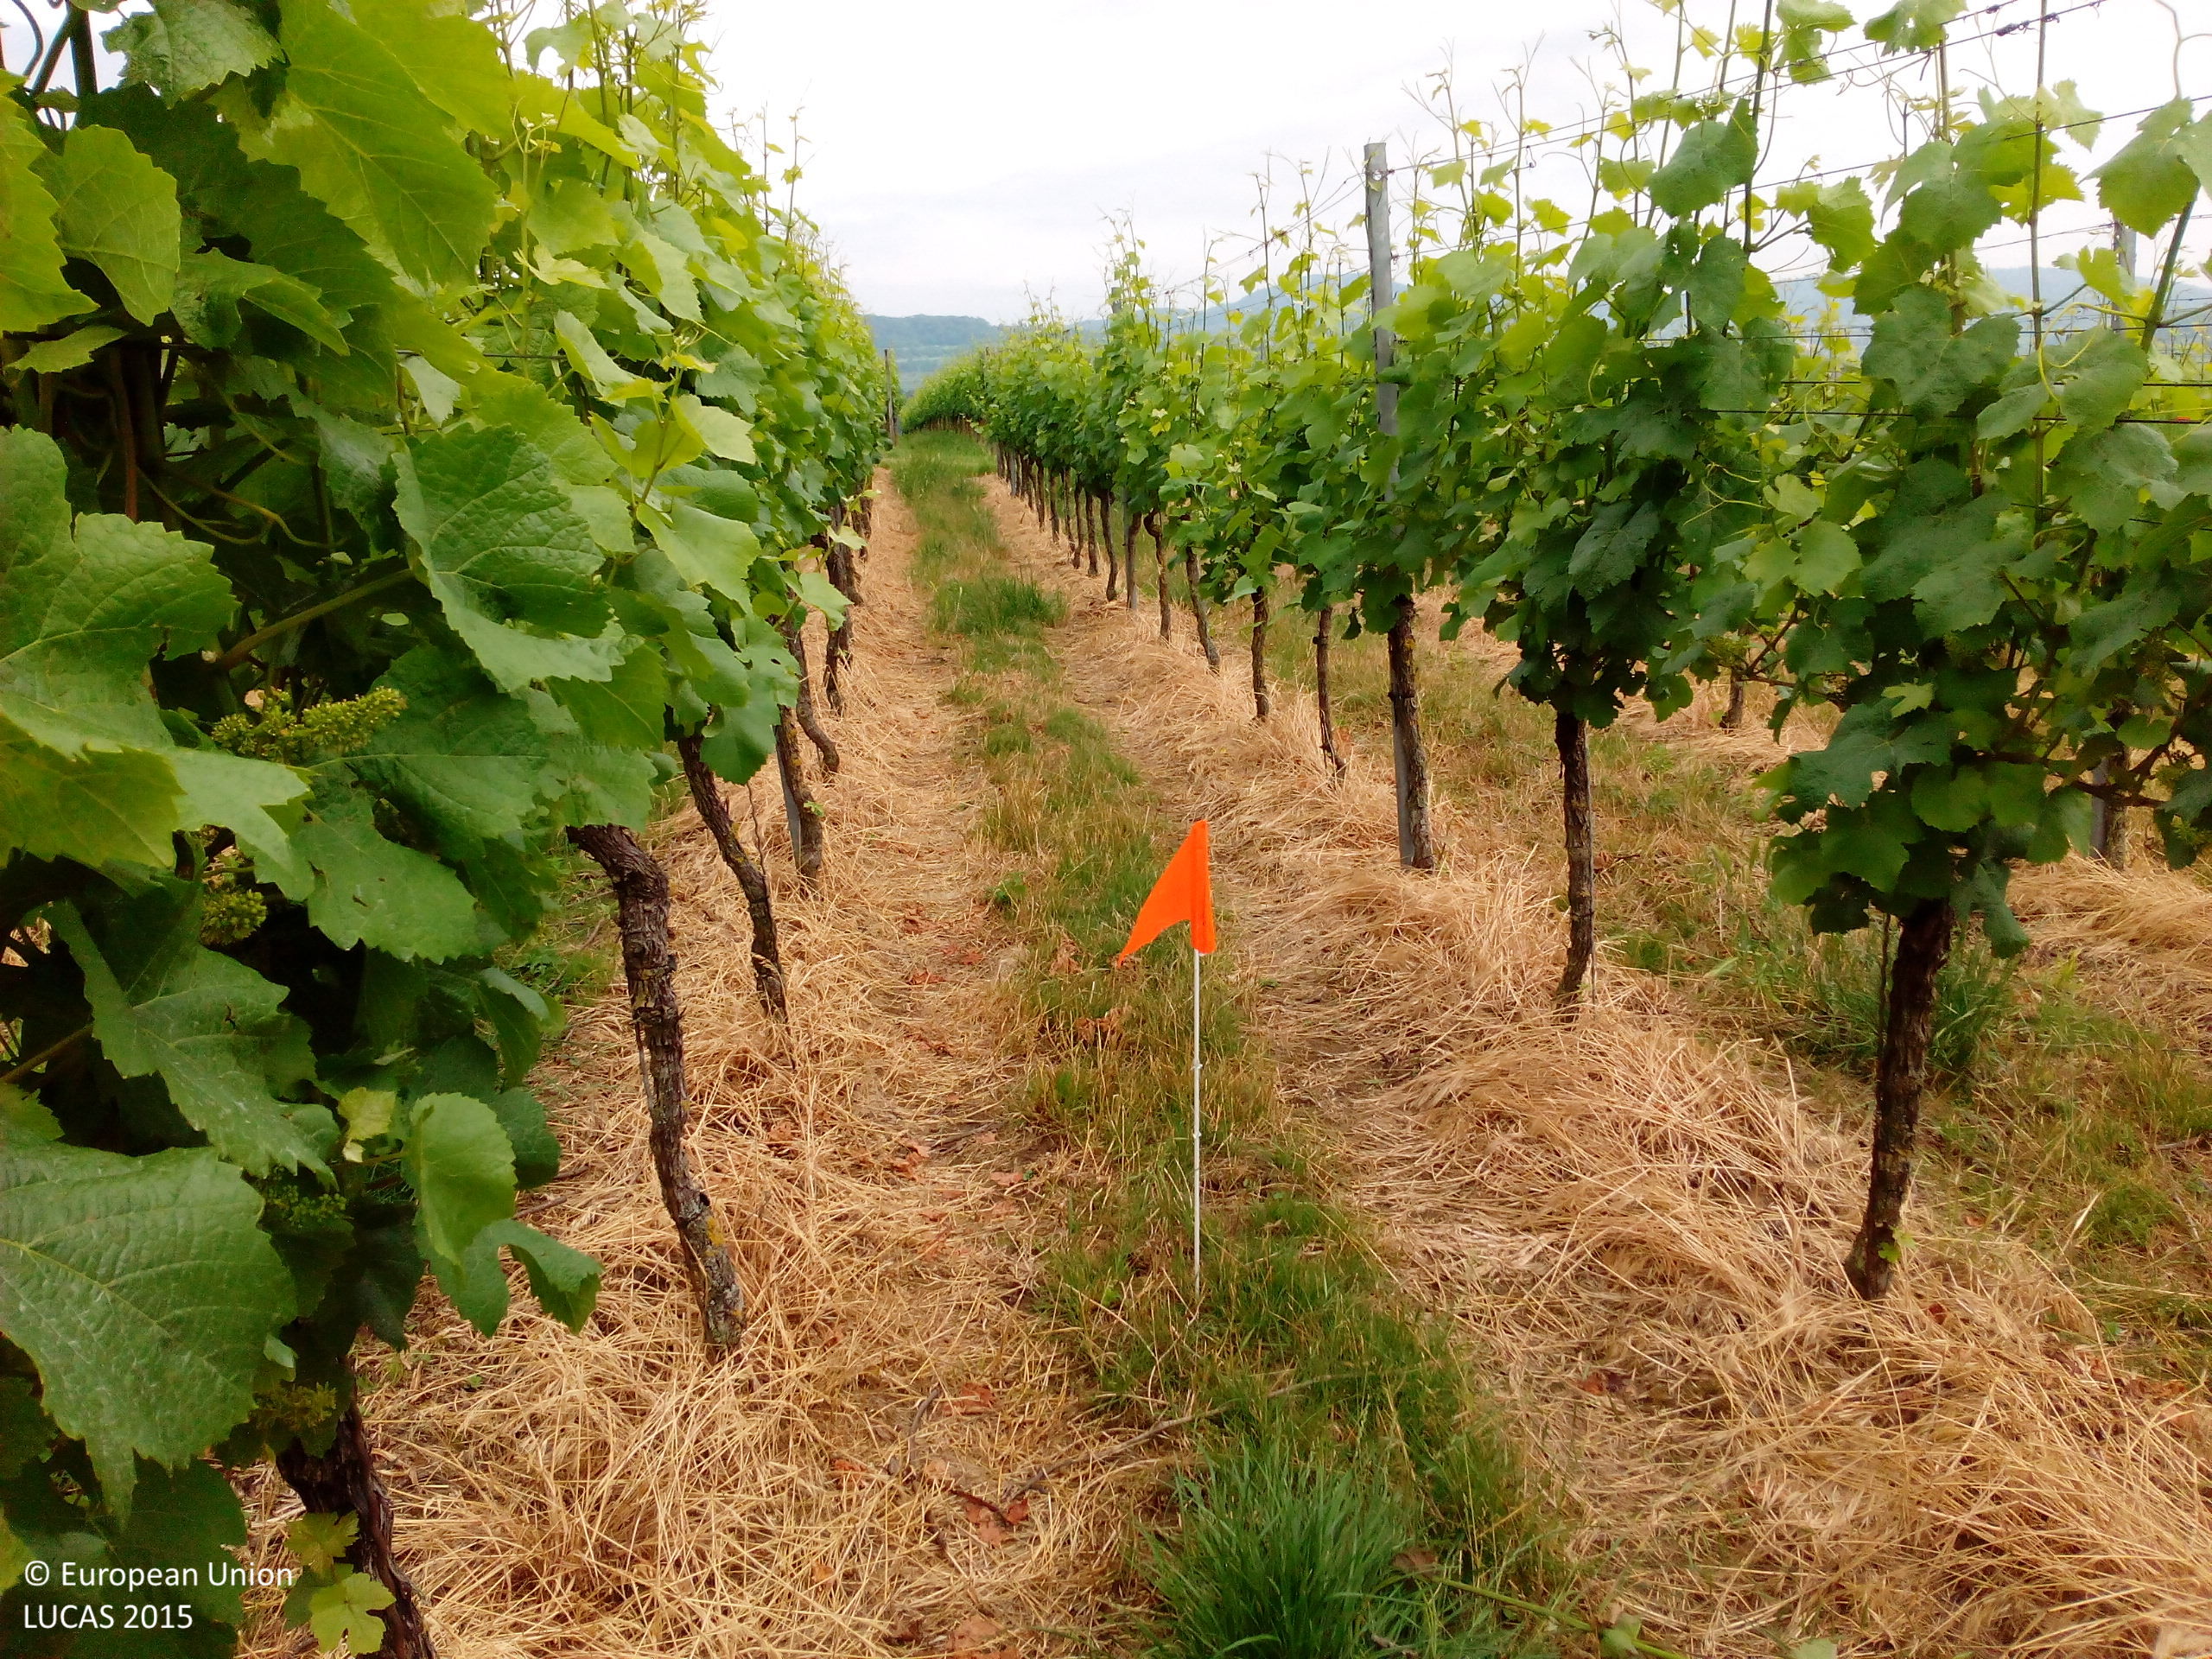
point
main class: Cropland
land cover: Vineyards
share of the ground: 25 - 50 %
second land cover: Grassland without tree/shrub cover
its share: 50 - 75 %
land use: Agriculture (excluding fallow land and kitchen gardens)
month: June
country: DE
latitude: 48.1074
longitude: 7.5971
